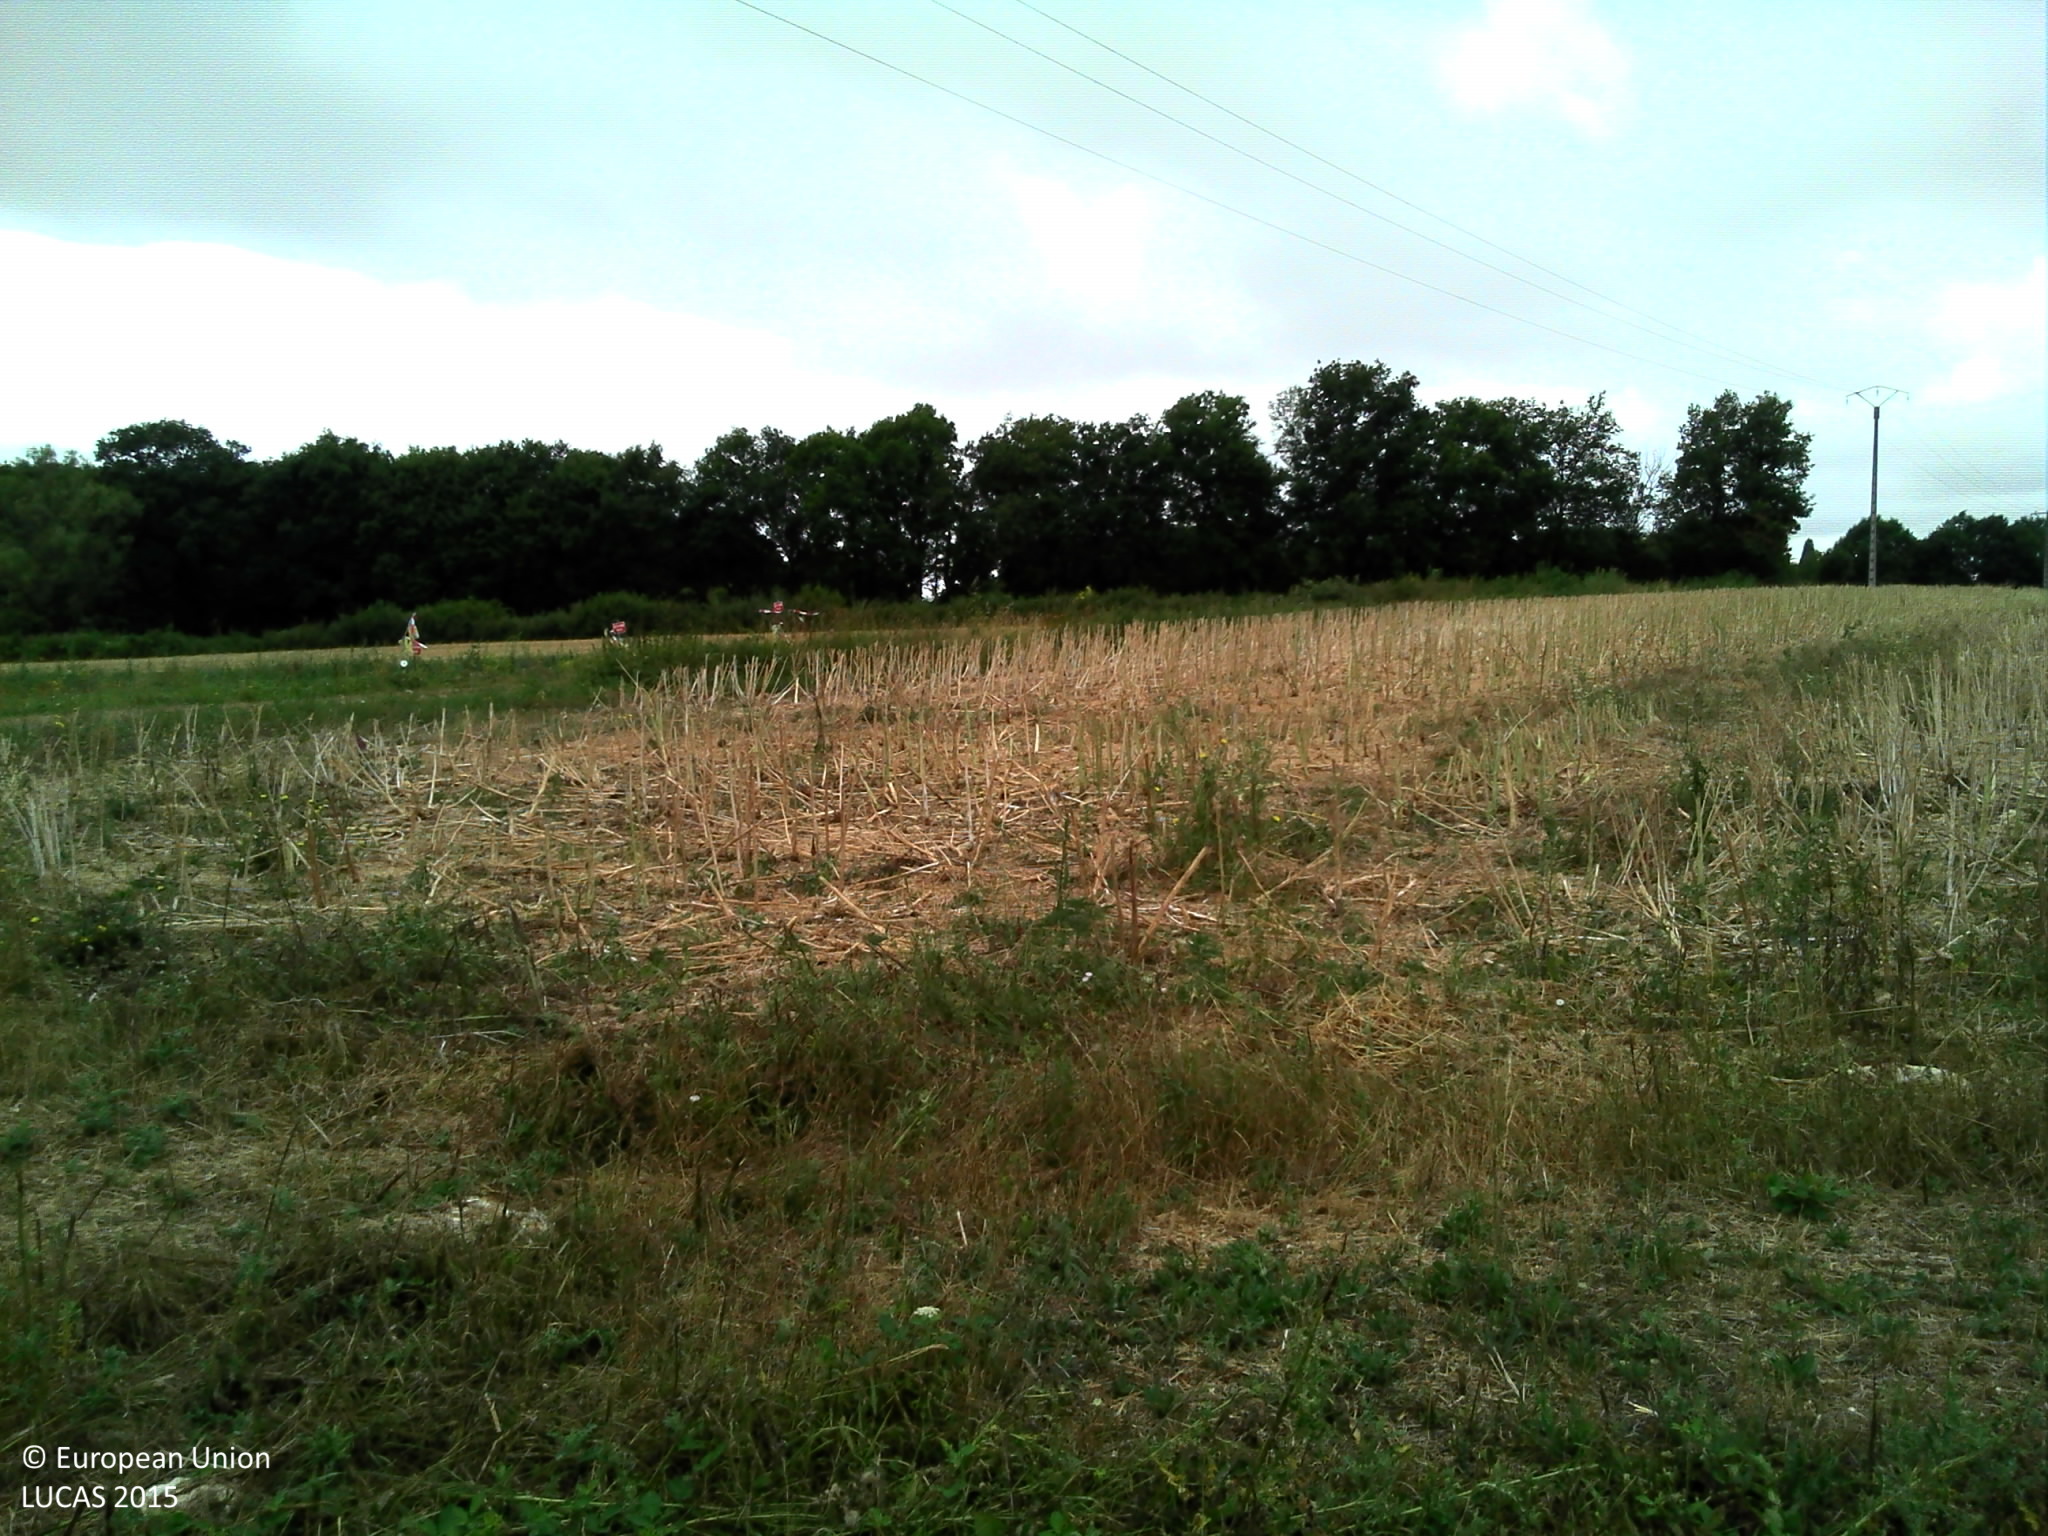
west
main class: Grassland
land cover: Grassland without tree/shrub cover
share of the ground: > 75 %
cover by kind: herbaceous plants 100 %
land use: Agriculture (excluding fallow land and kitchen gardens)
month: July
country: FR
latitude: 46.2430
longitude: 0.5816
